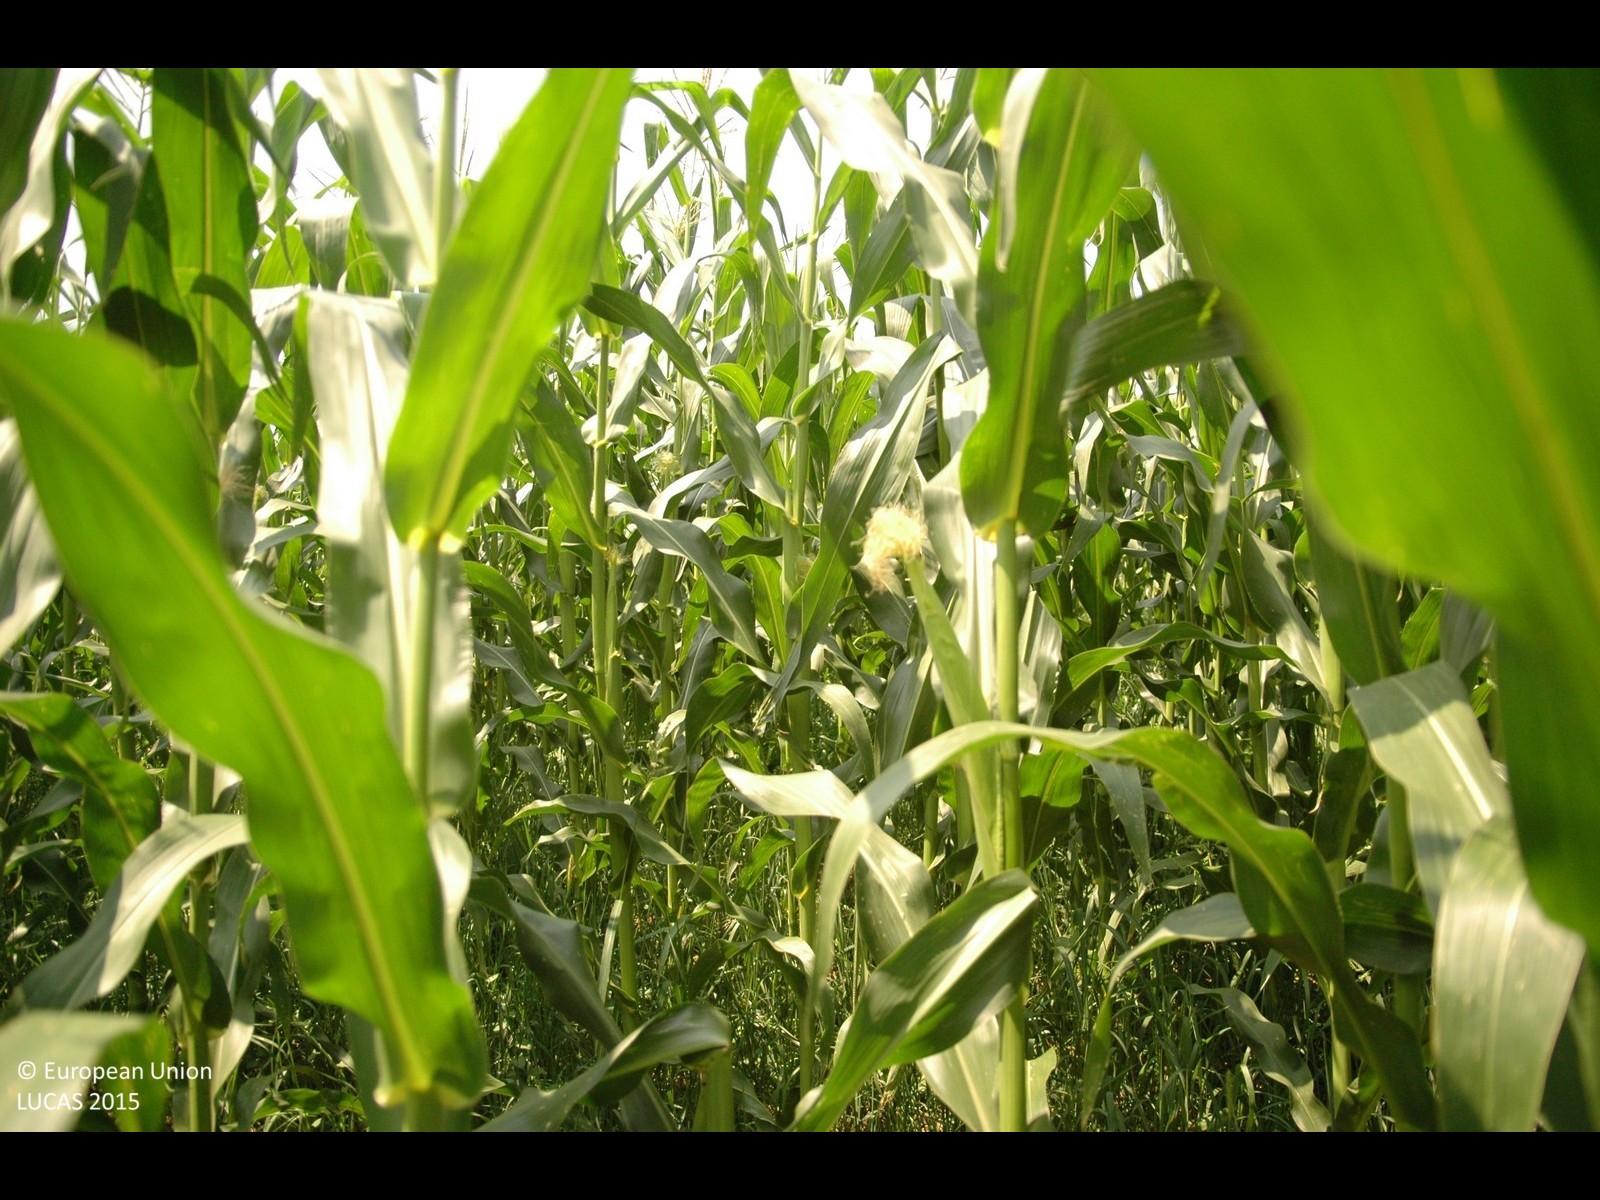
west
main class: Cropland
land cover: Maize
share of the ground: > 75 %
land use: Agriculture (excluding fallow land and kitchen gardens)
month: July
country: HR
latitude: 46.1412
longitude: 16.0963
